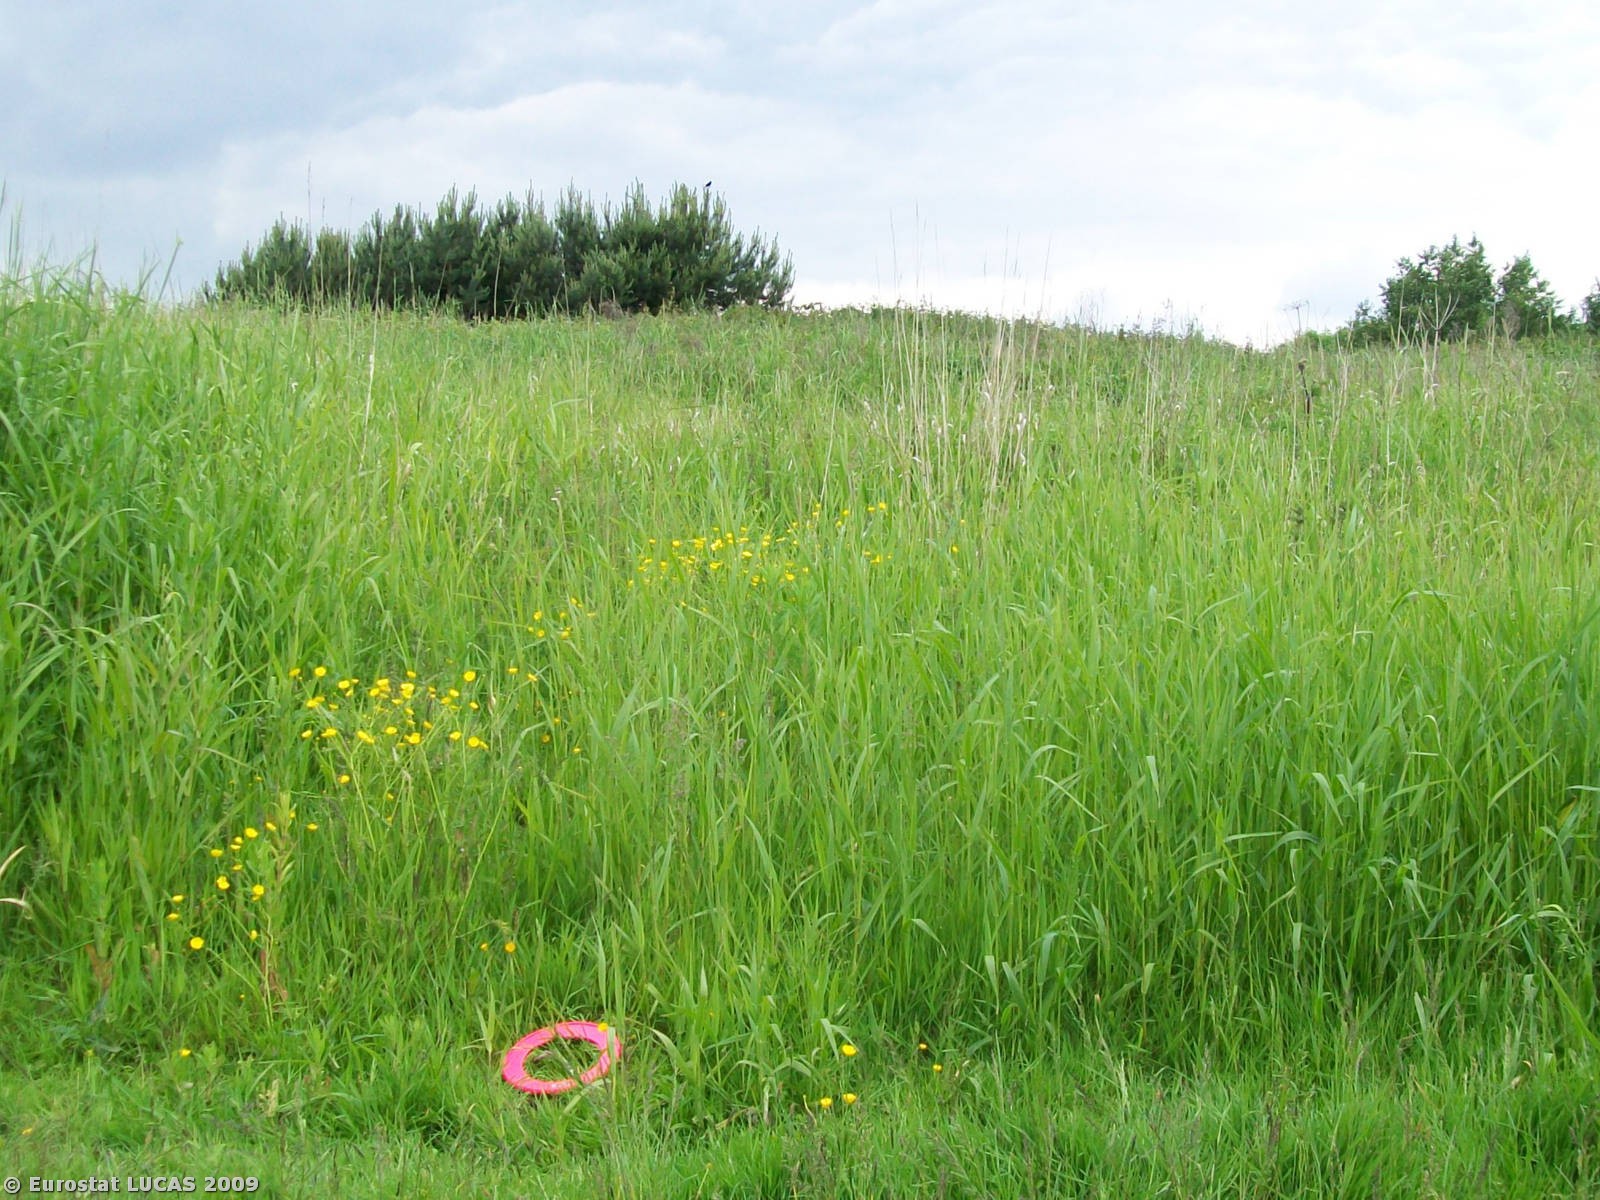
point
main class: Grassland
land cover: Grassland with sparse tree/shrub cover
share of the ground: < 10 %
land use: Amenities, museums, leisure
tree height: > 5 m
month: June
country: GB
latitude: 53.4099
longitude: -2.8128
